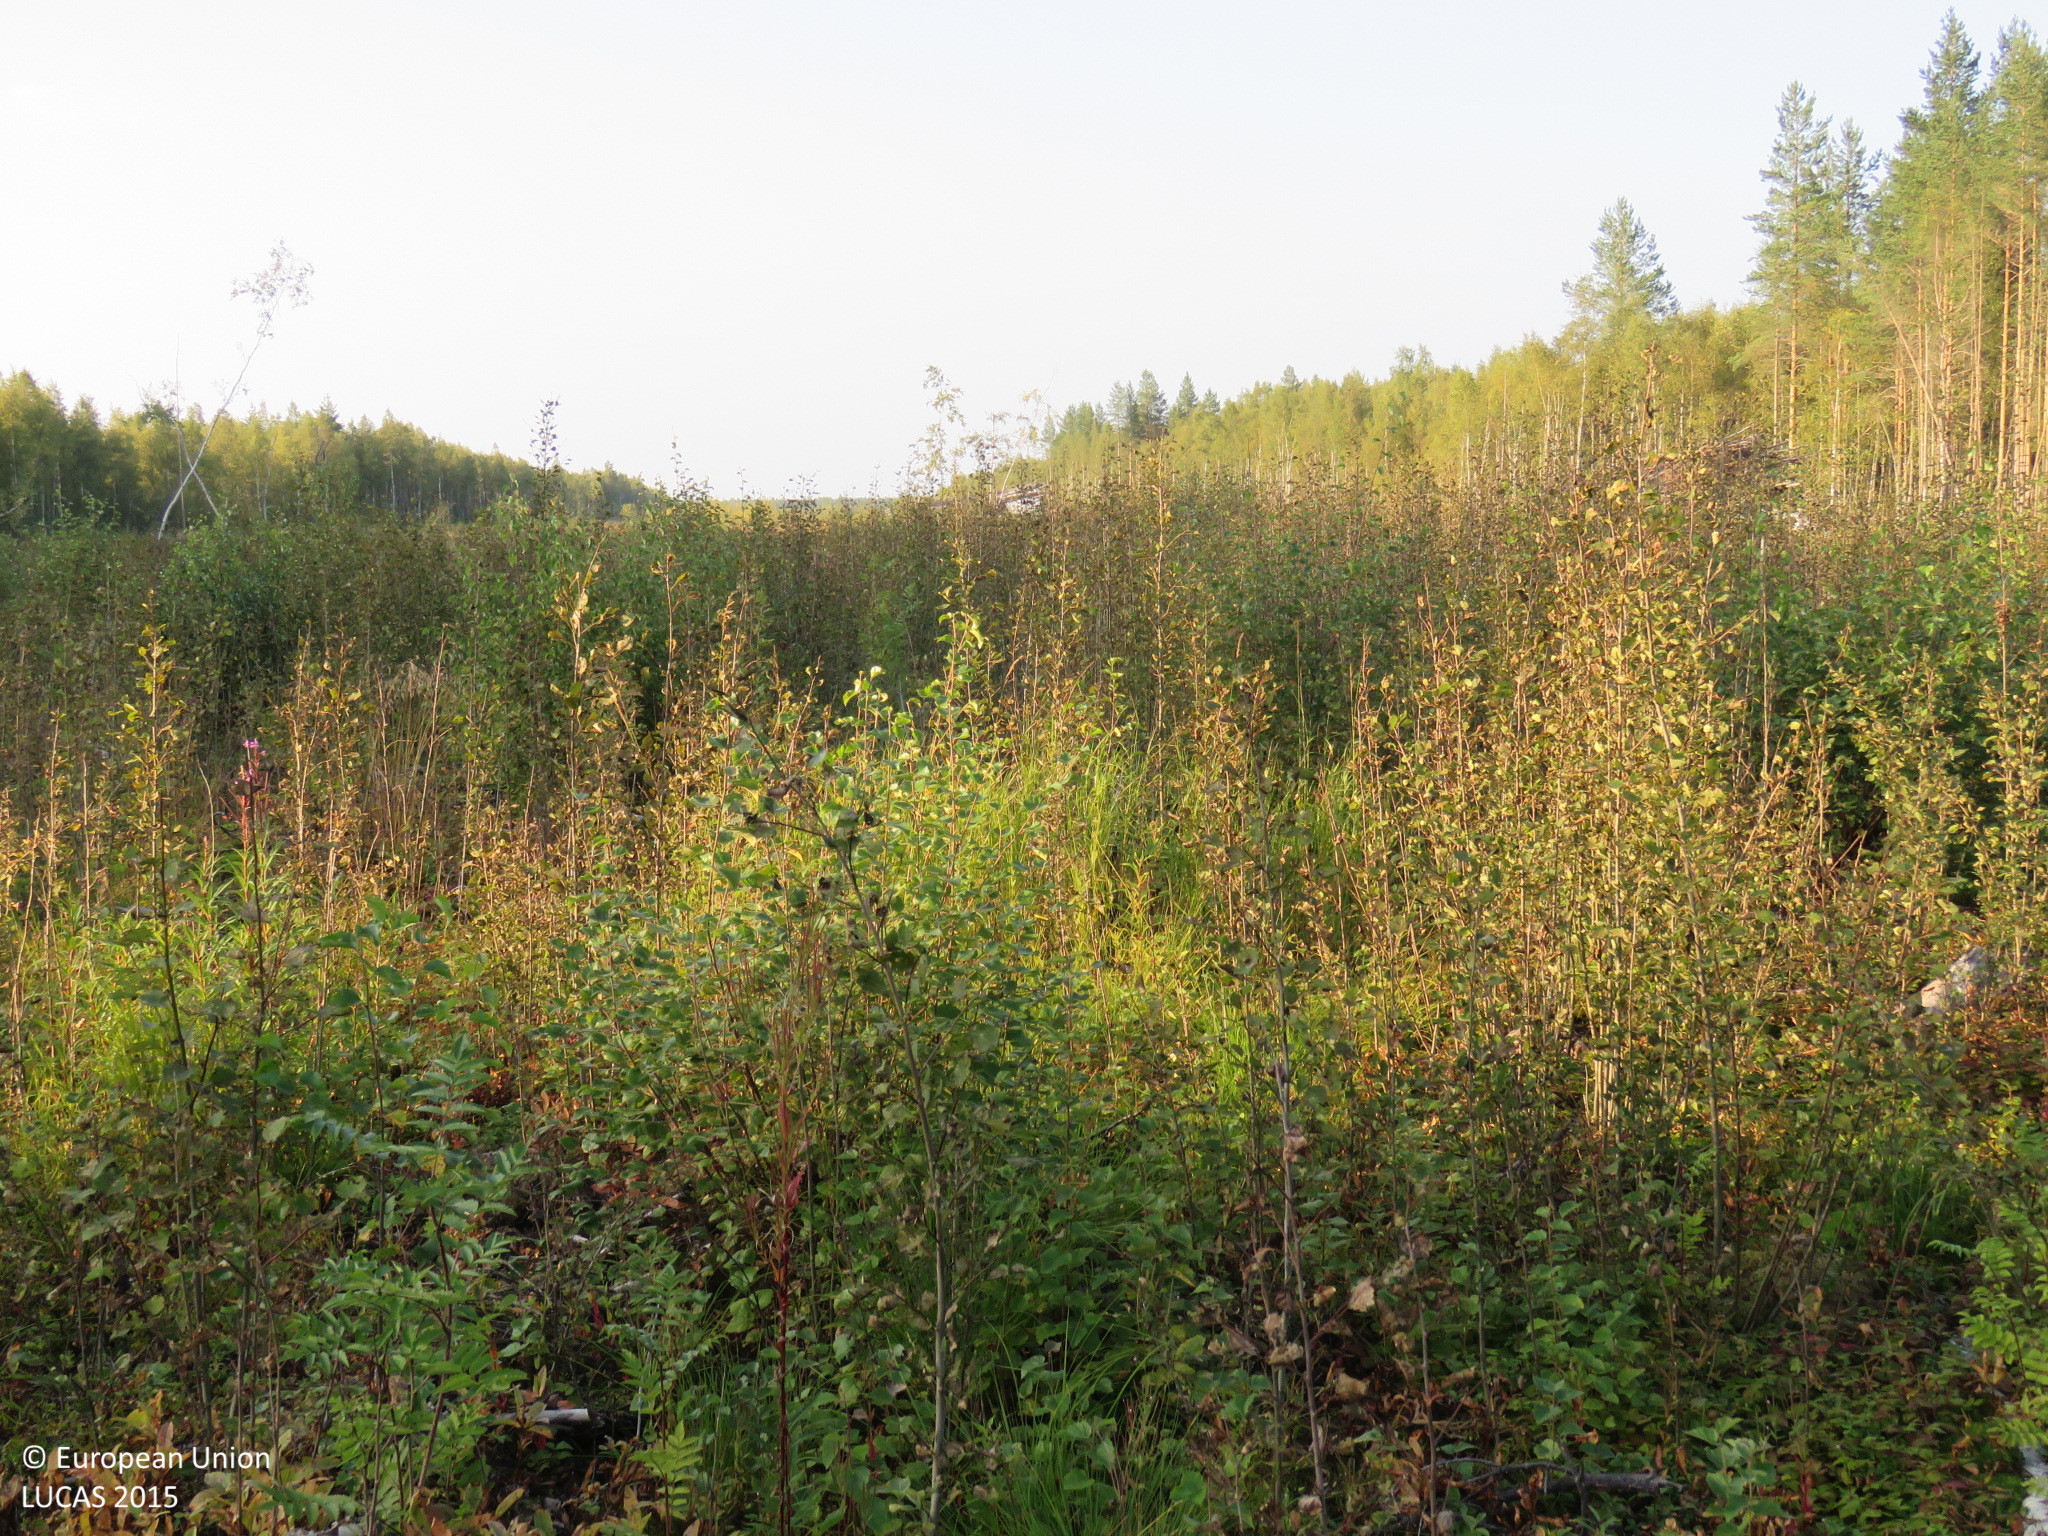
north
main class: Woodland
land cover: Broadleaved woodland
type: non-riverine alder, birch or aspen forest
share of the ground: 50 - 75 %
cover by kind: broadleaved forest trees 60 %, herbaceous plants 30 %, lichens and mosses 10 %
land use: Forestry
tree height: < 5 m
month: August
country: FI
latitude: 64.8756
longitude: 25.4297
